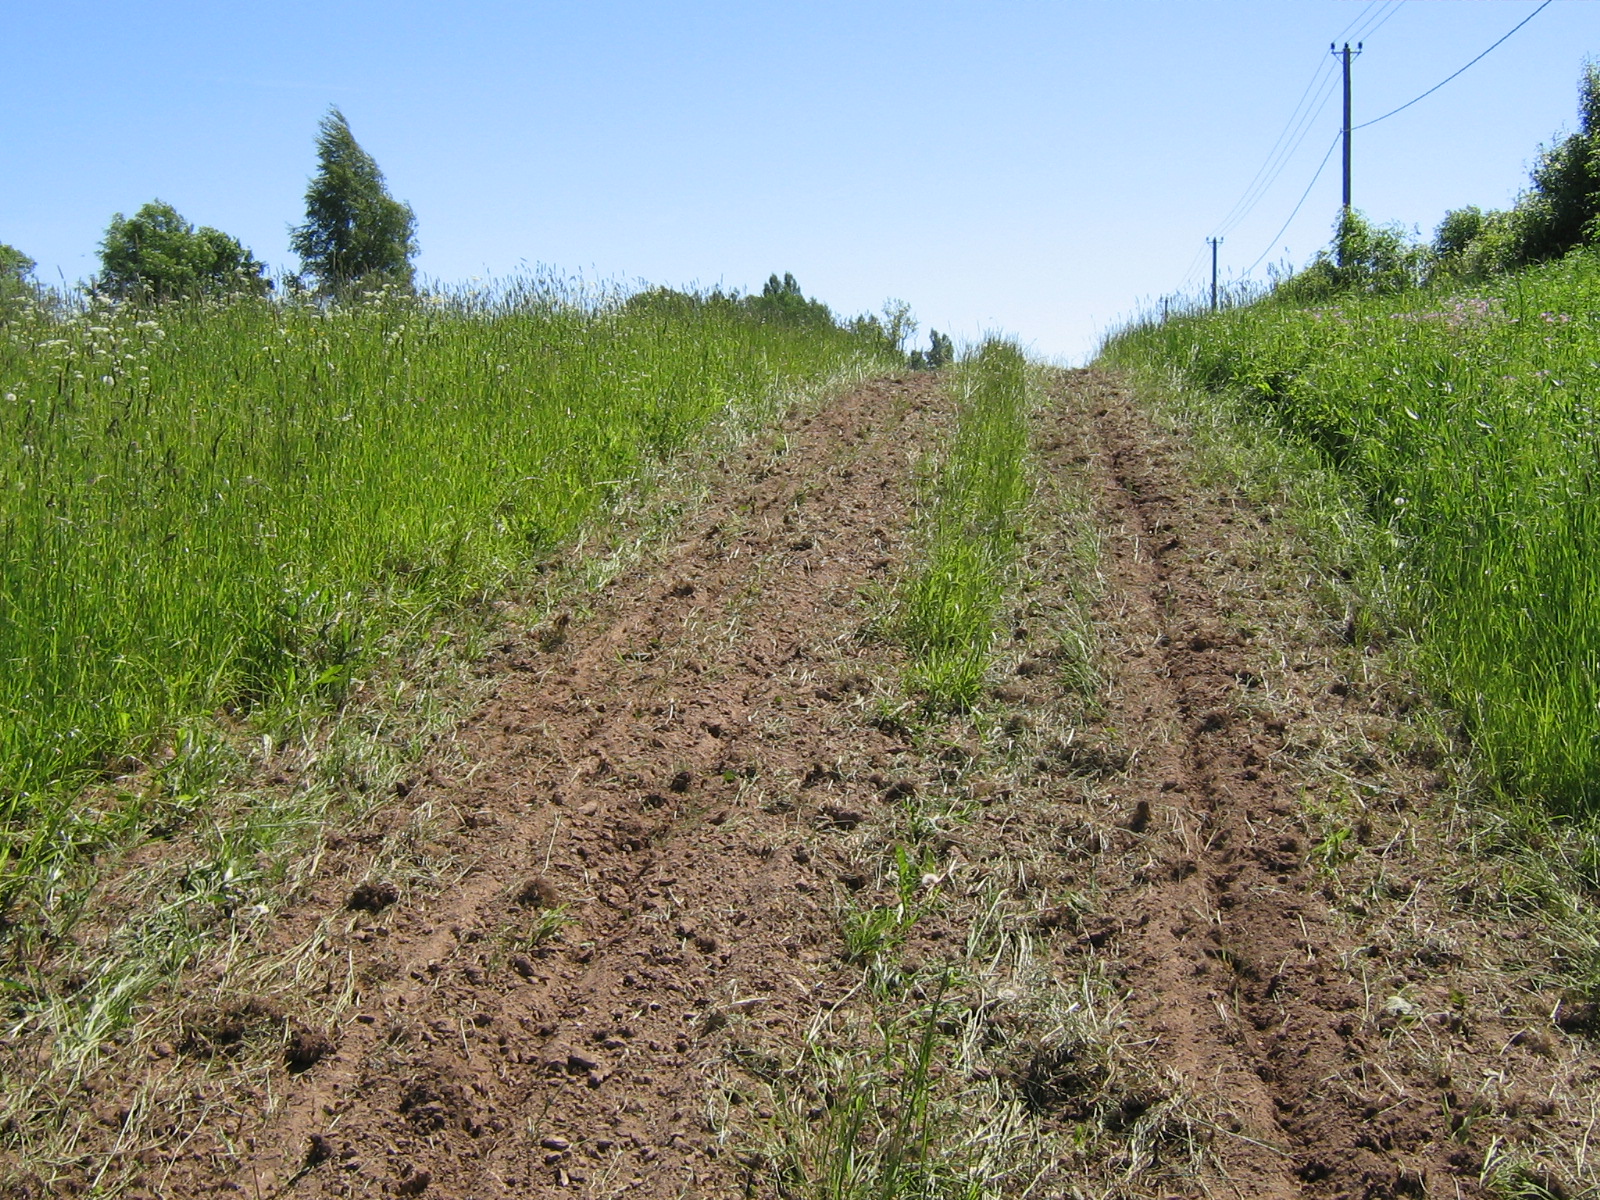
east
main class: Grassland
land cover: Grassland without tree/shrub cover
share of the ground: > 75 %
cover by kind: herbaceous plants 100 %
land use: Agriculture (excluding fallow land and kitchen gardens)
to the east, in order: Grassland without tree/shrub cover; Tracks; Grassland without tree/shrub cover; Shrubland without tree cover; Grassland with sparse tree/shrub cover; Broadleaved woodland
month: June
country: LV
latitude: 57.1206
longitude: 25.8667
